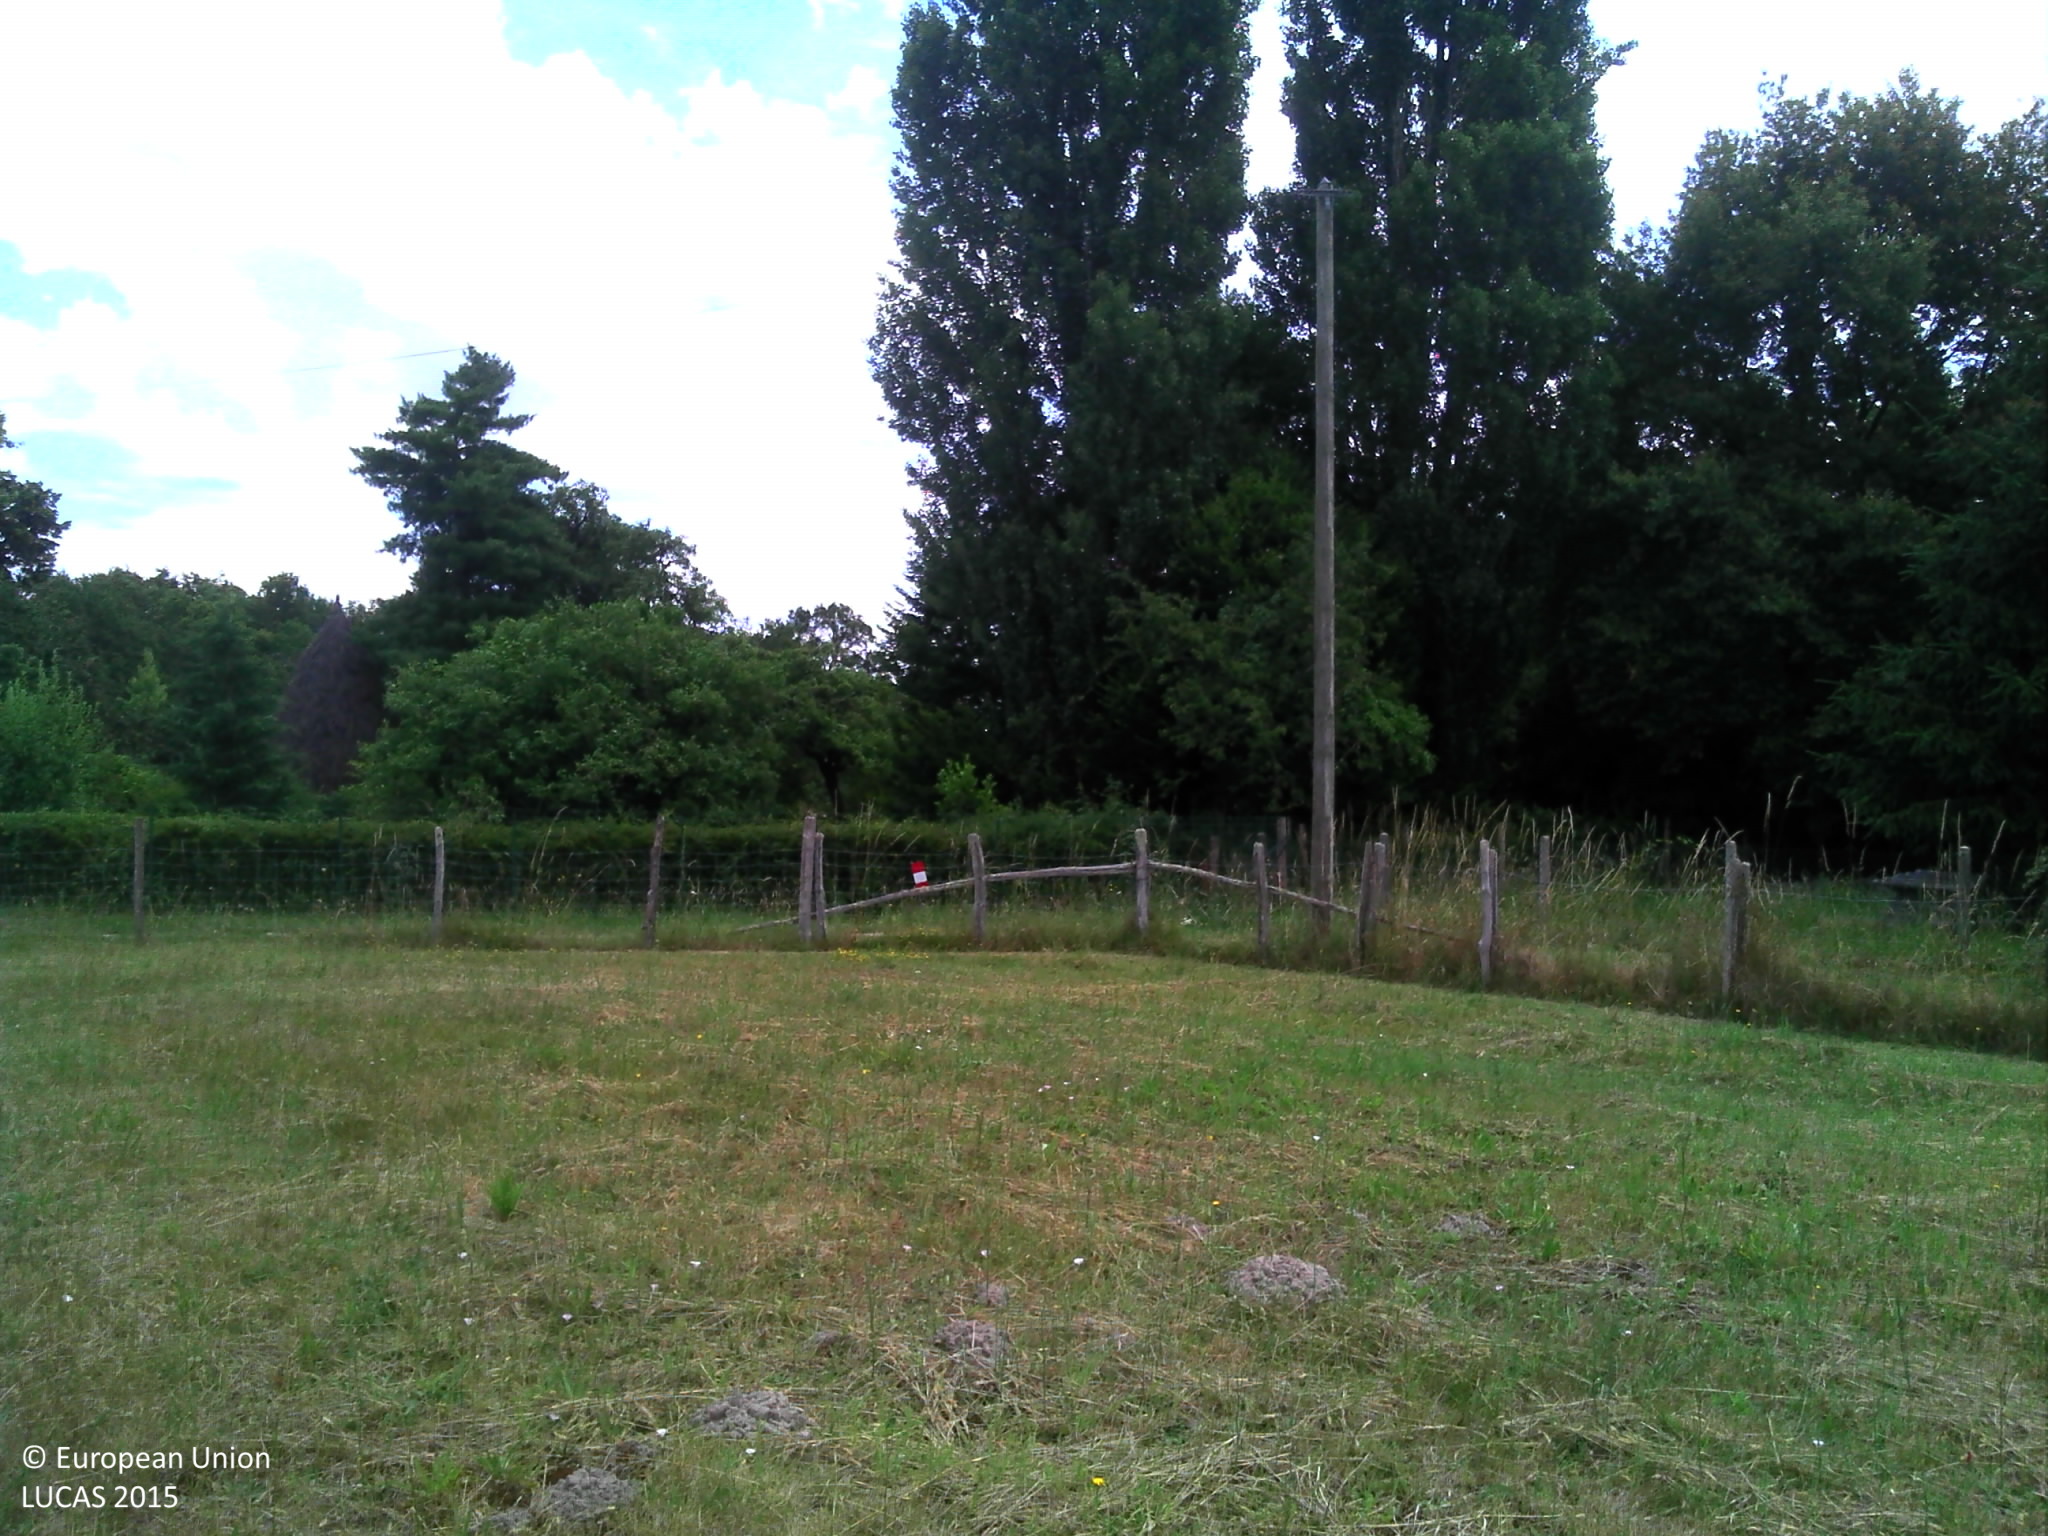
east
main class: Grassland
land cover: Grassland without tree/shrub cover
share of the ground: > 75 %
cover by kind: herbaceous plants 100 %
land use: Agriculture (excluding fallow land and kitchen gardens)
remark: Harvested field
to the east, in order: Grassland without tree/shrub cover; Fences; Electric lines; Grass margins; Tracks; Grass margins; Fences; Grassland with sparse tree/shrub cover; Grassland without tree/shrub cover; Broadleaved woodland; Grassland with sparse tree/shrub cover; Fences; Grassland without tree/shrub cover; Broadleaved woodland; Grass margins; Tracks; Grass margins
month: June
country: FR
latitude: 47.4226
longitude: 0.3940
